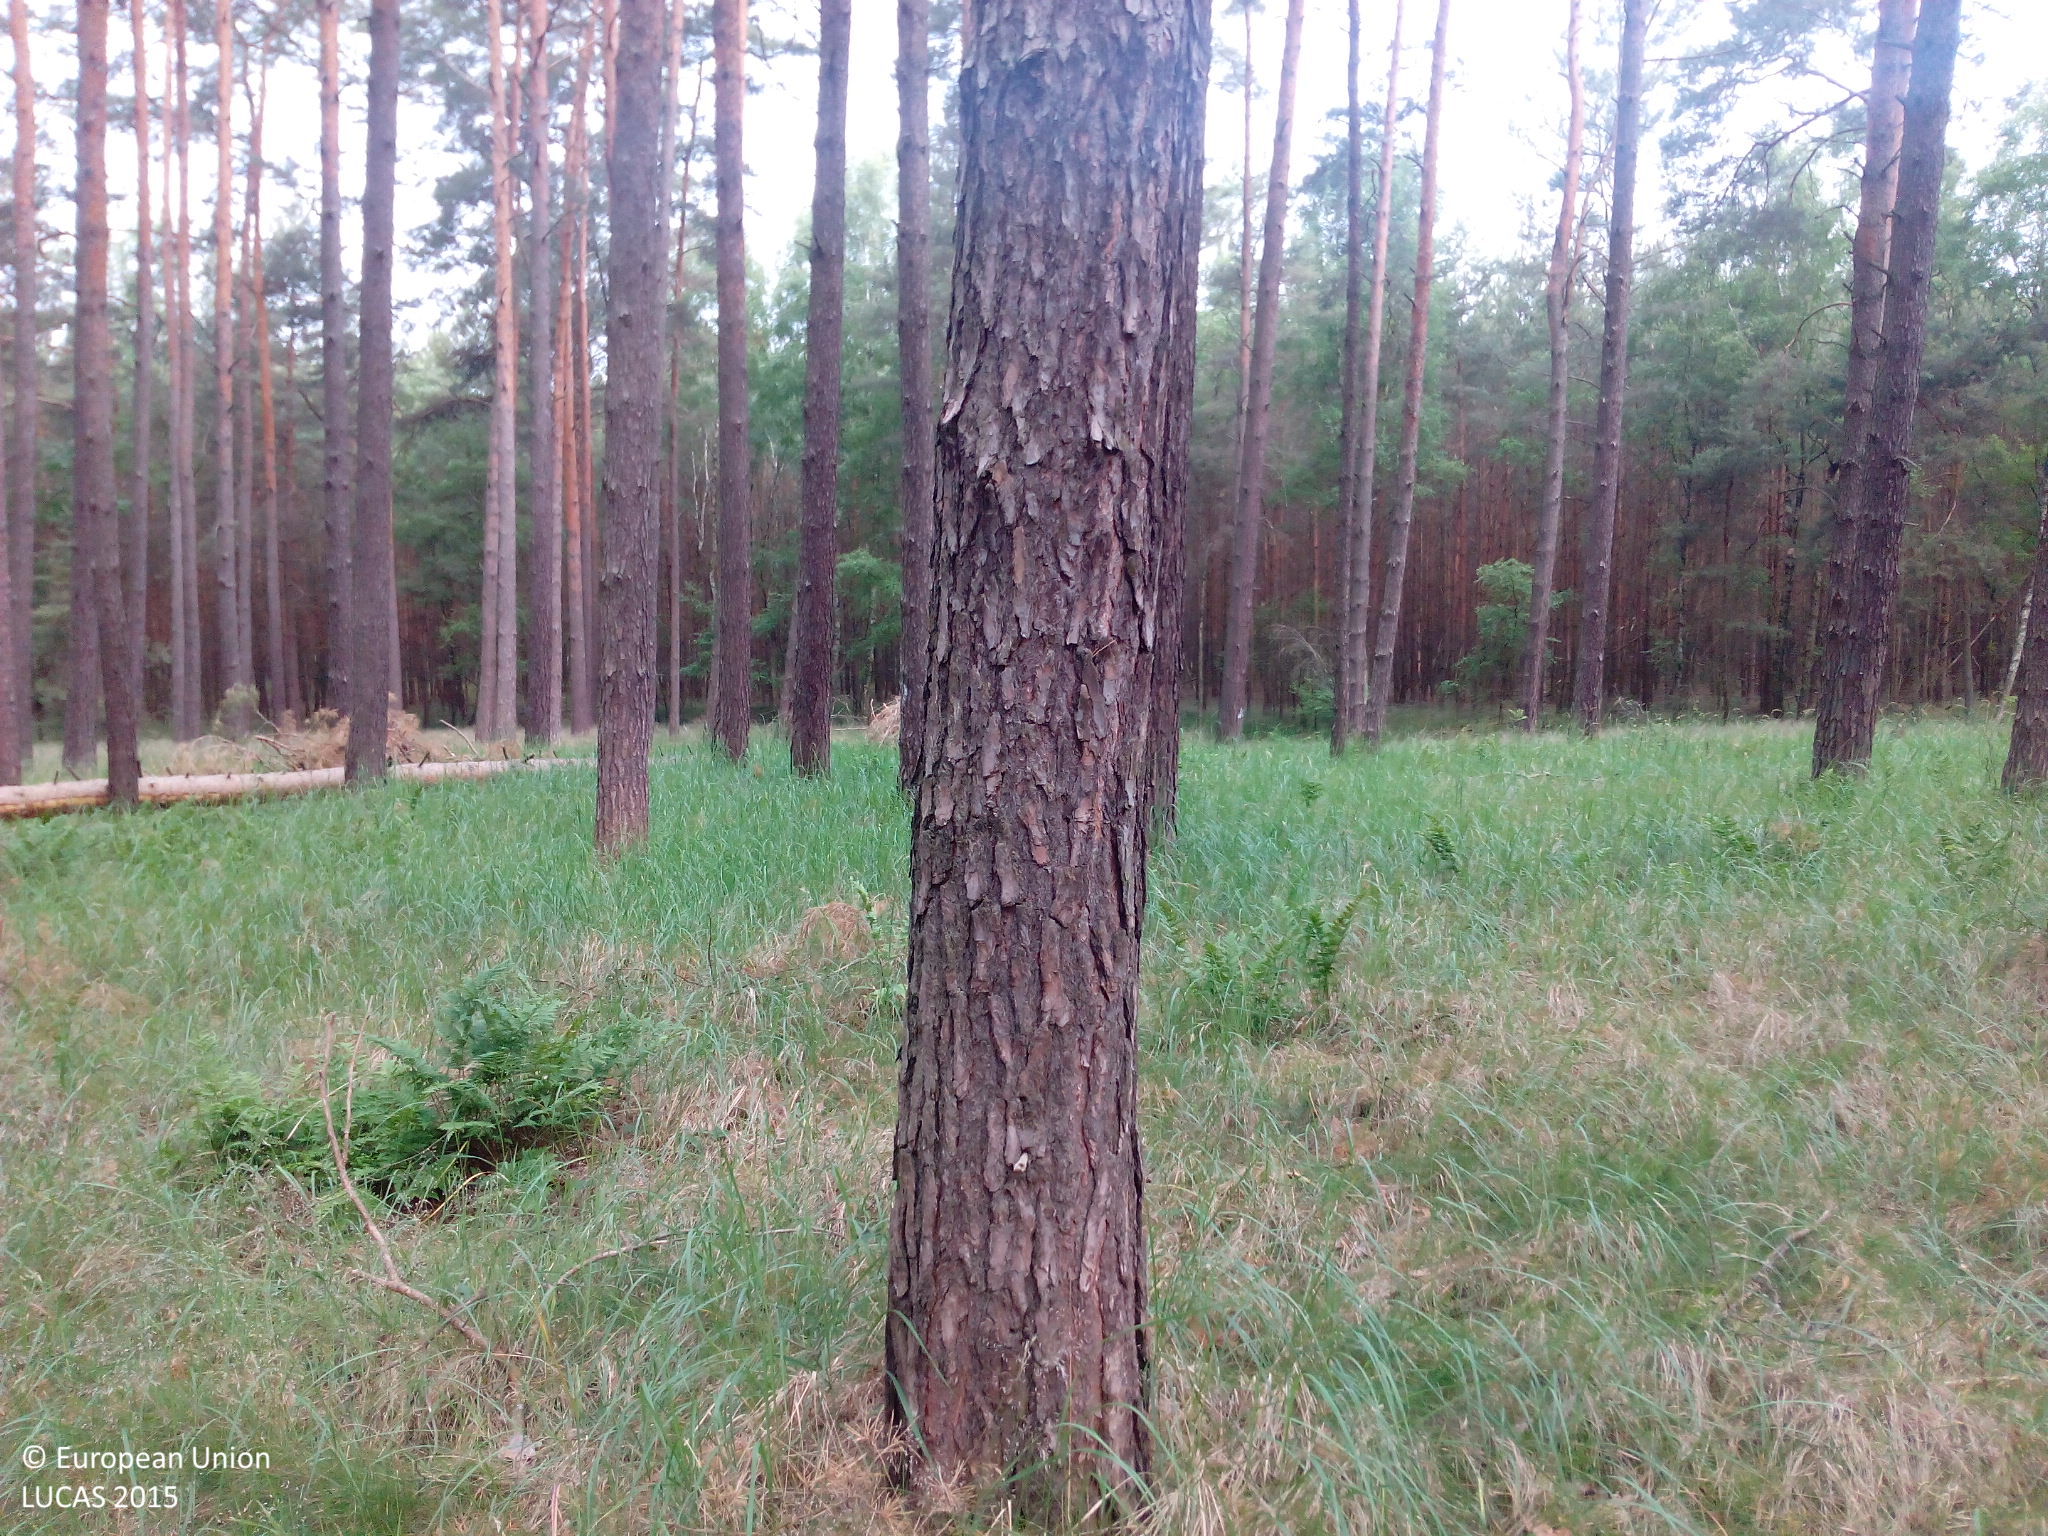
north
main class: Woodland
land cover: Pine dominated coniferous woodland
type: hemiboreal forest and nemoral coniferous forest and mixed broadleaved-coniferous forest
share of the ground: > 75 %
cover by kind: coniferous forest trees 90 %, herbaceous plants 5 %, lichens and mosses 5 %
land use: Forestry
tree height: > 5 m
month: June
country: DE
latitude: 52.1929
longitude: 12.3256
